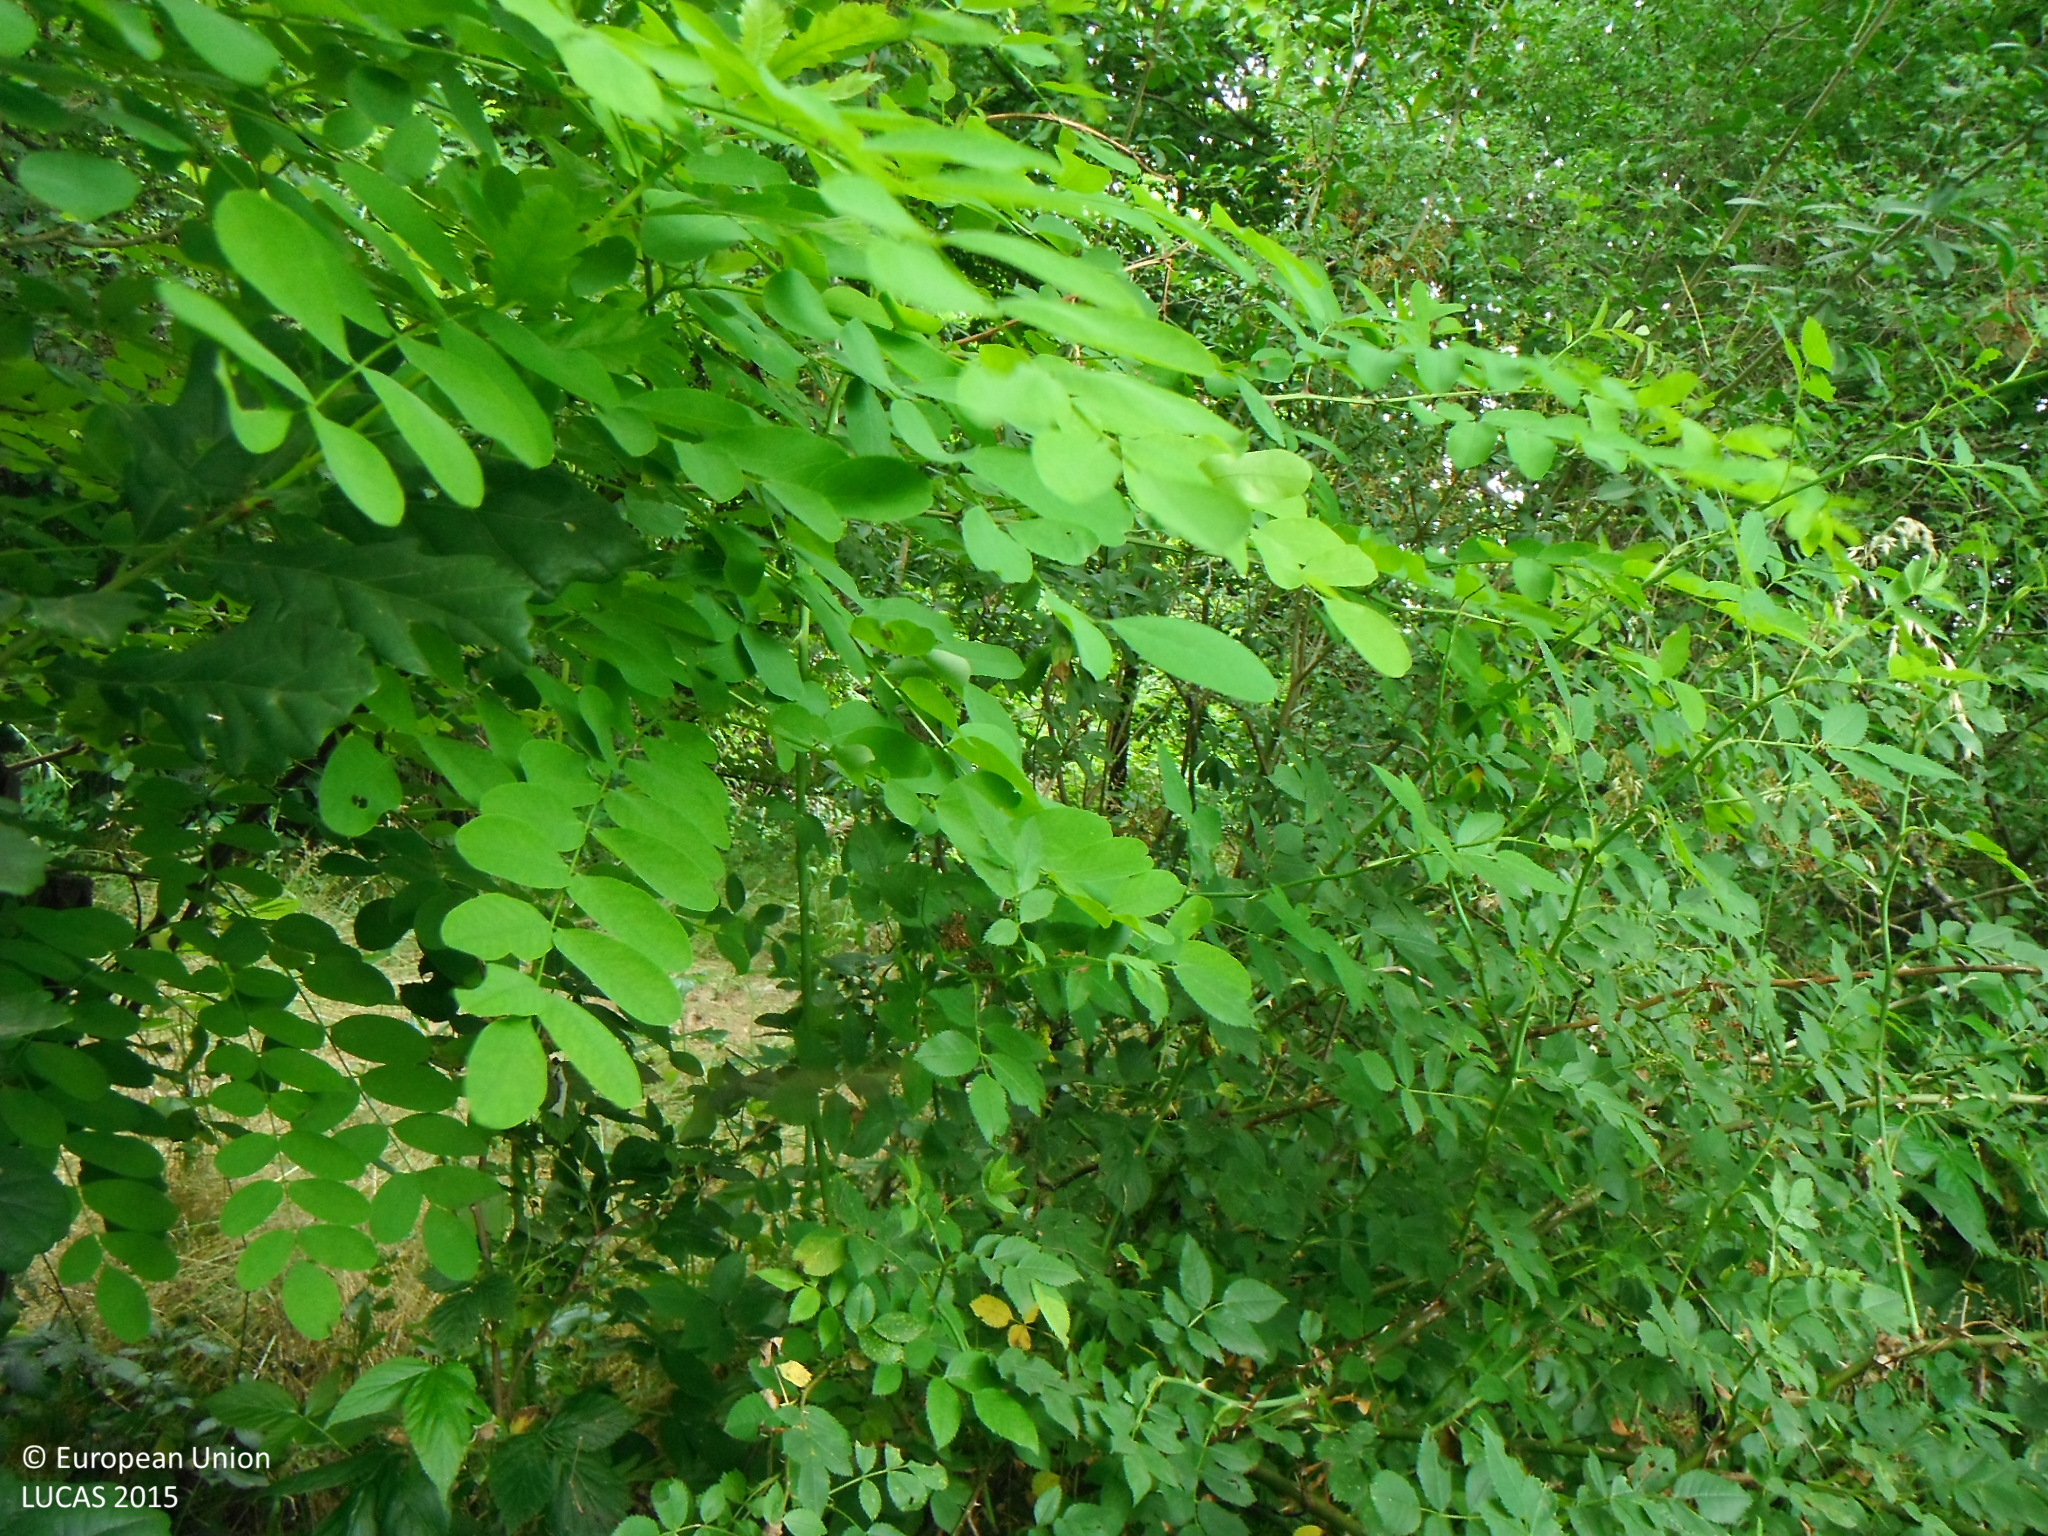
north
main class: Woodland
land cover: Broadleaved woodland
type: exotic forest
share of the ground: > 75 %
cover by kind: broadleaved forest trees 80 %, shrubs 10 %, herbaceous plants 10 %
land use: Forestry
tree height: > 5 m
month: June
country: SK
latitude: 48.5793
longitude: 20.0473
